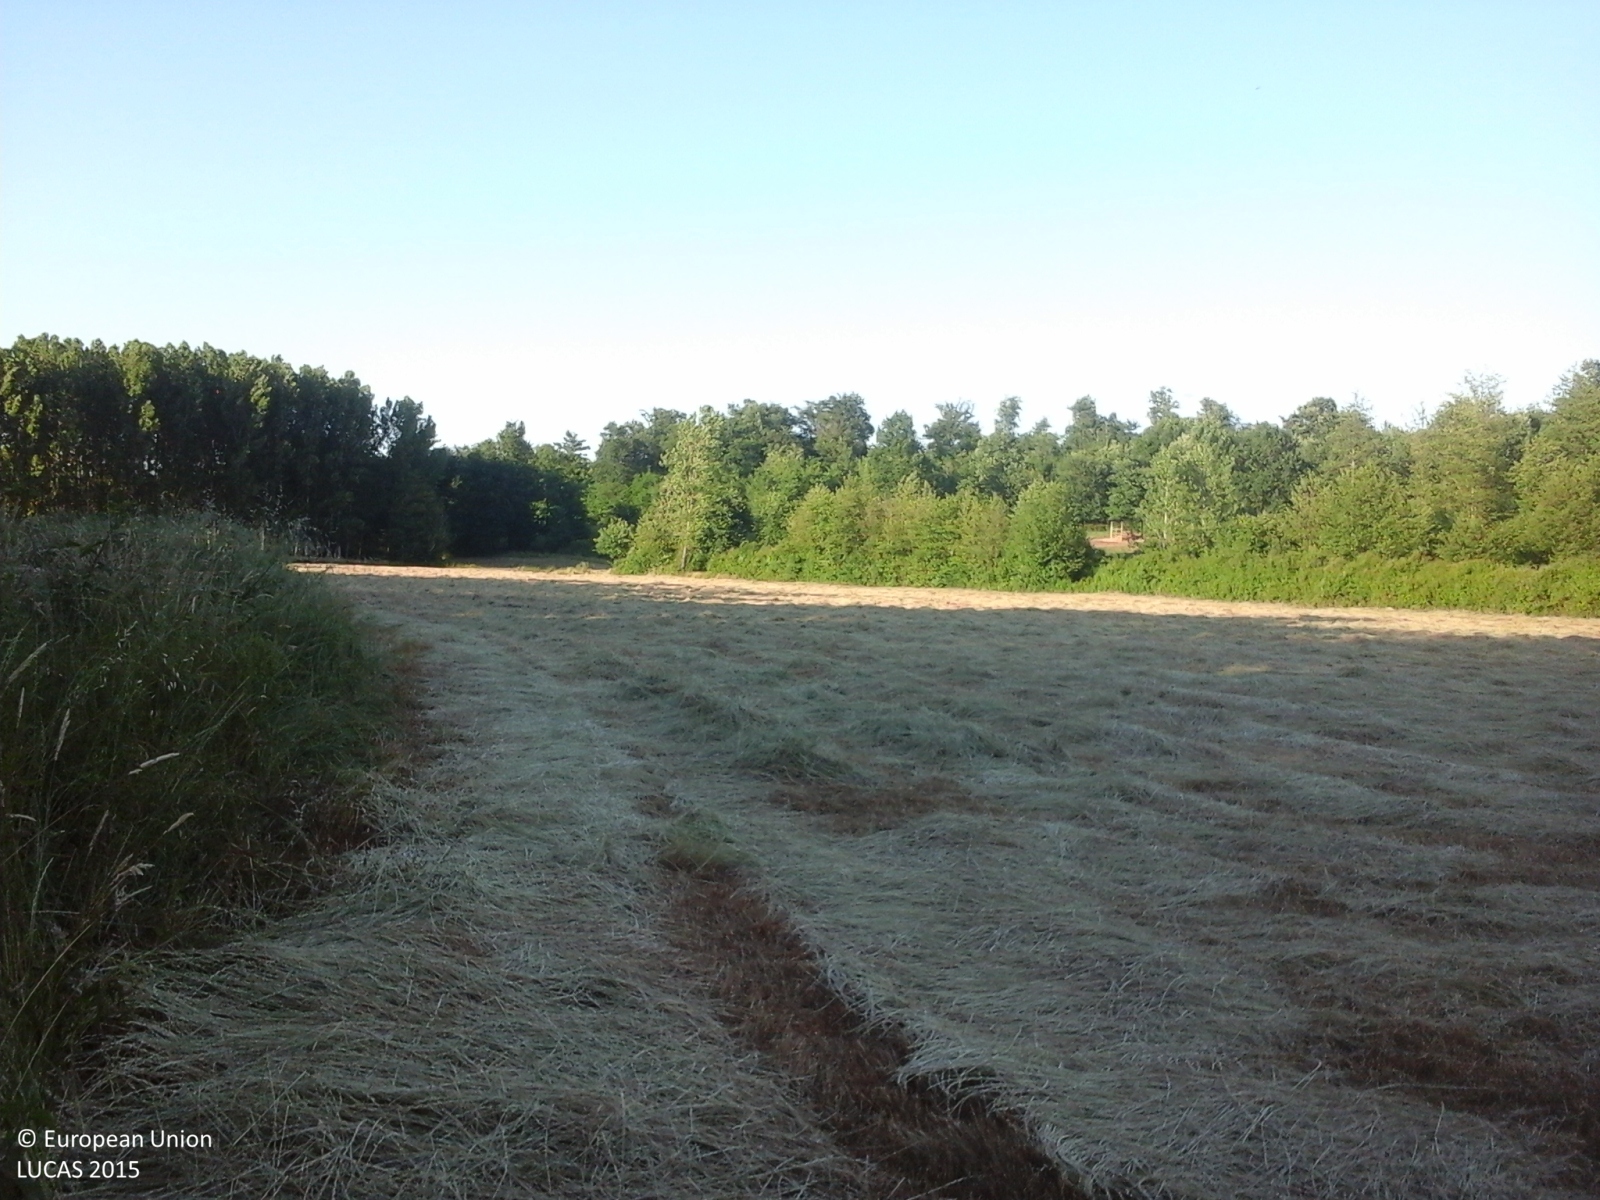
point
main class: Cropland
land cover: Temporary grasslands
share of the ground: > 75 %
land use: Agriculture (excluding fallow land and kitchen gardens)
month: May
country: IT
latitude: 43.7708
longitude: 10.7063
